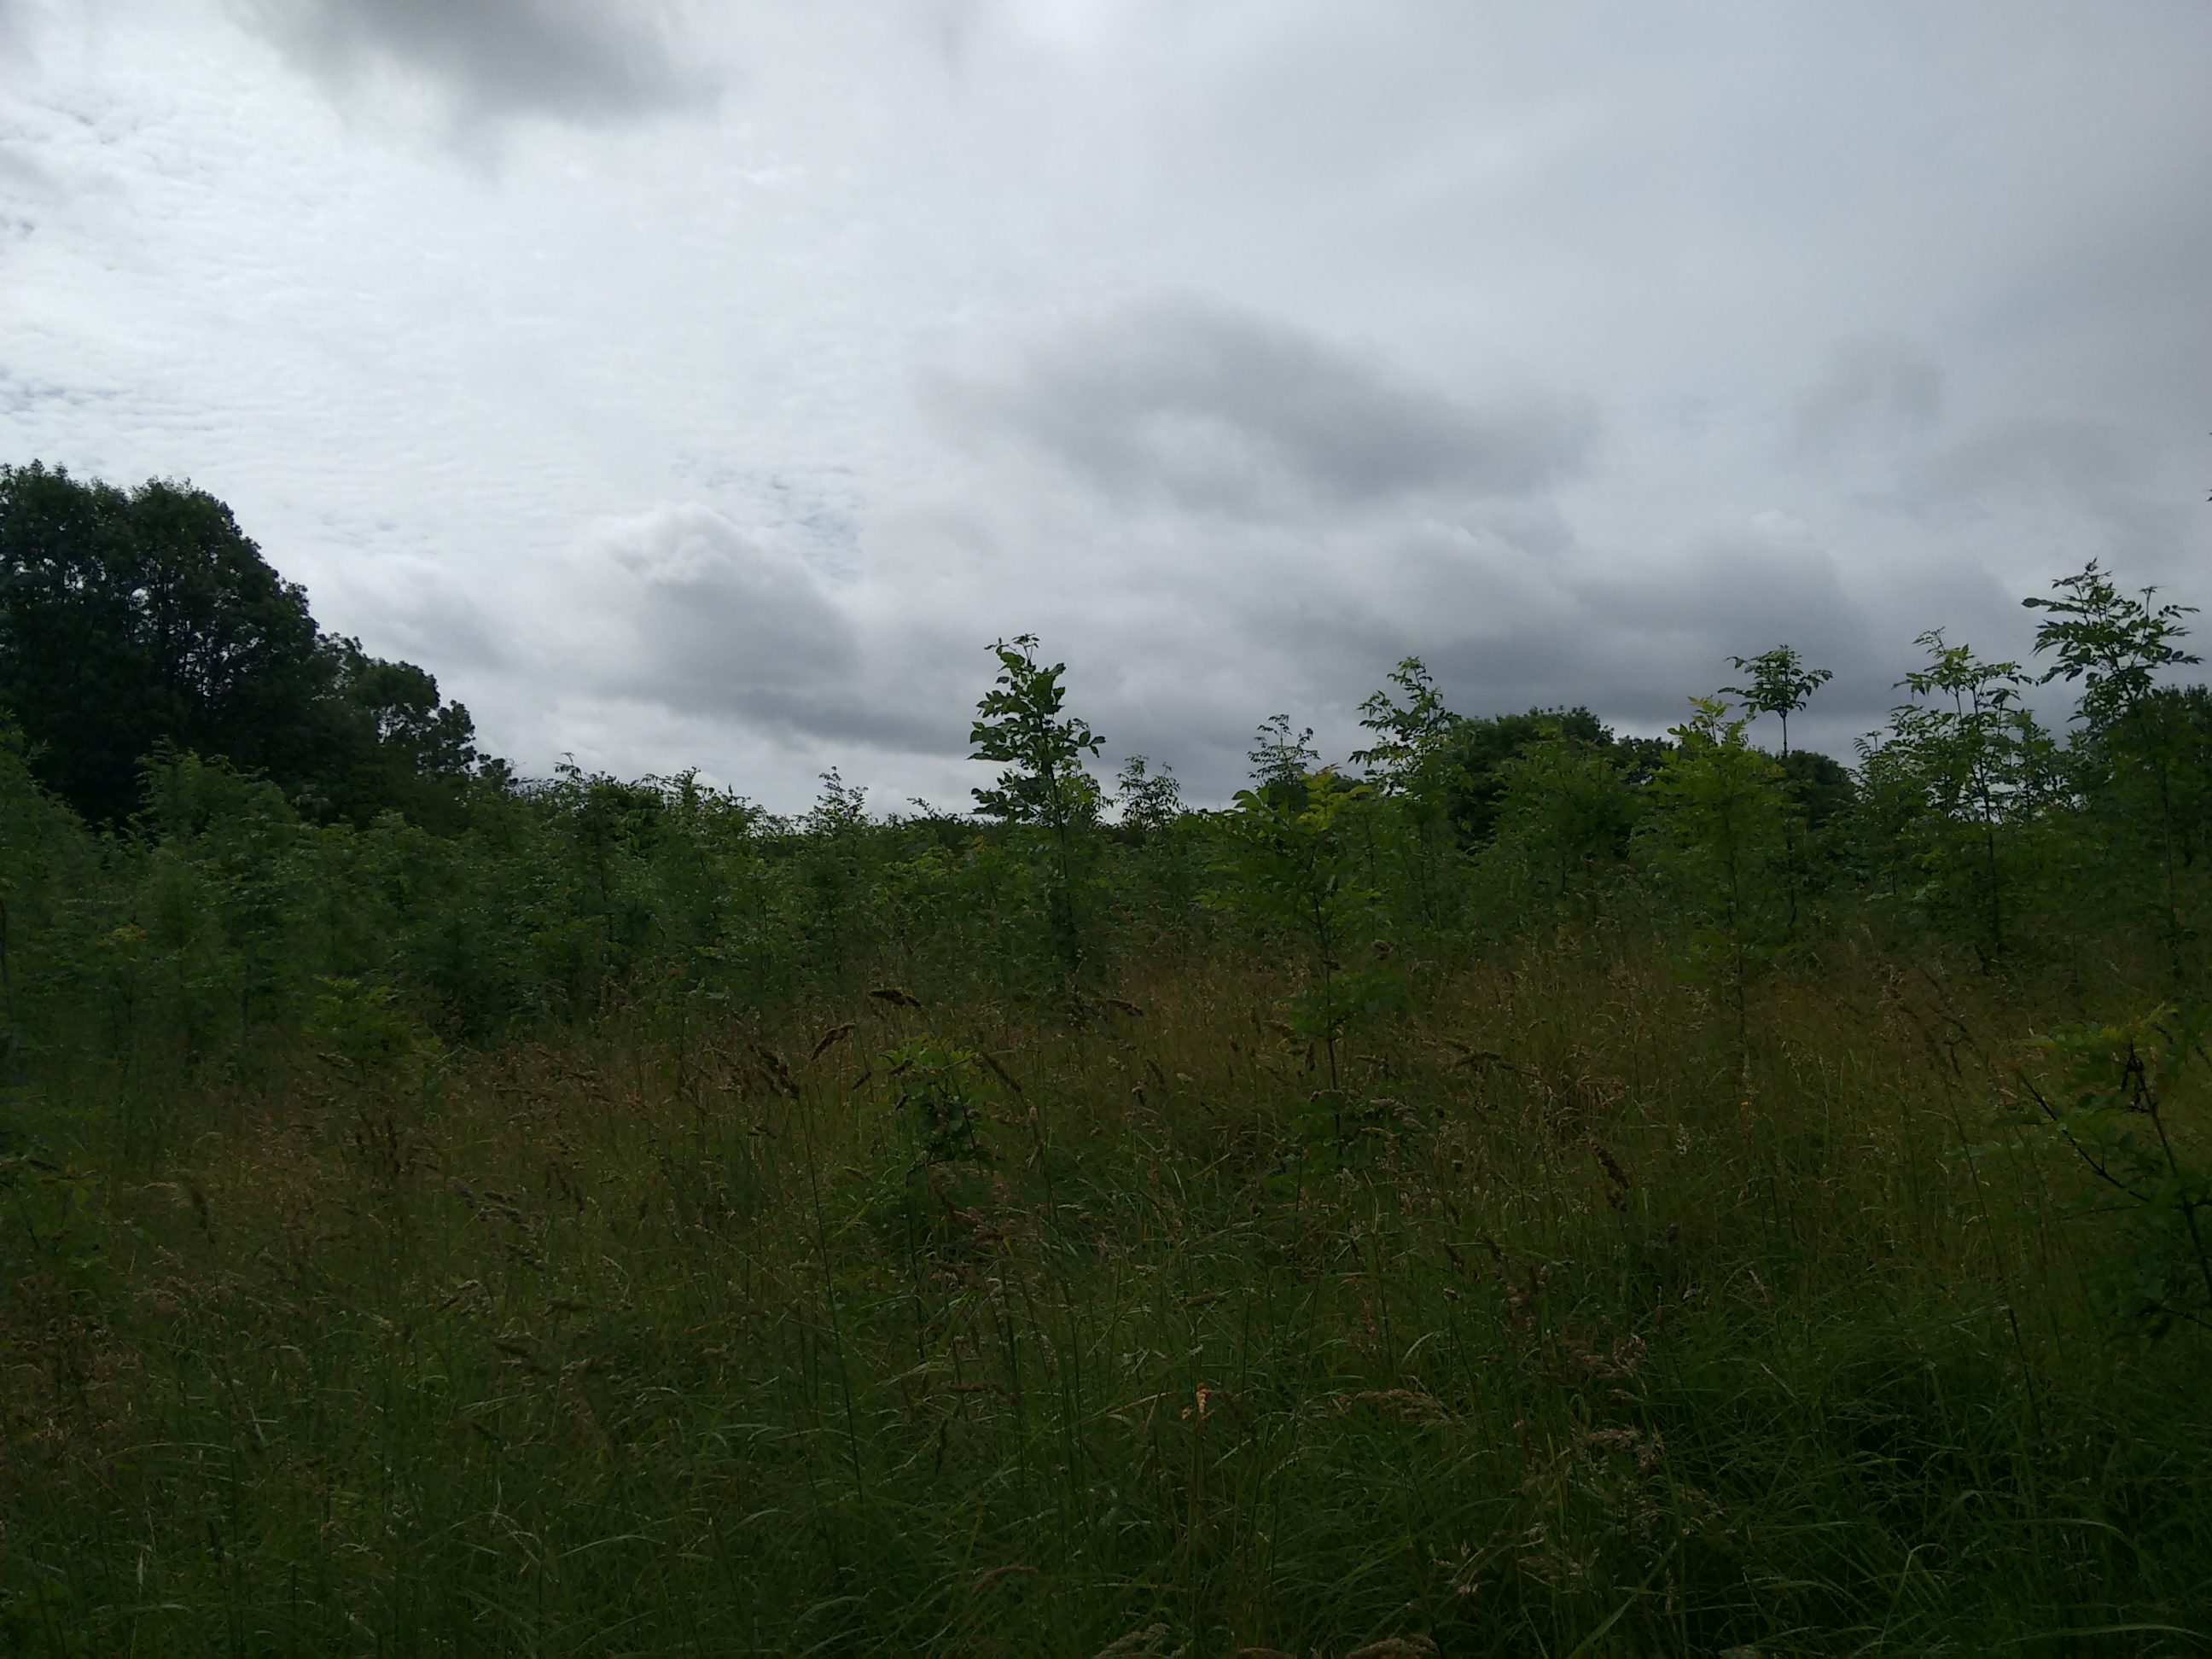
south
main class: Woodland
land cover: Broadleaved woodland
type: acidophilous oak and oak-birch forest
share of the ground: 50 - 75 %
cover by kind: broadleaved forest trees 70 %, herbaceous plants 30 %
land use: Forestry
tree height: < 5 m
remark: Nursery
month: June
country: IE
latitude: 53.3245
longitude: -7.7785
